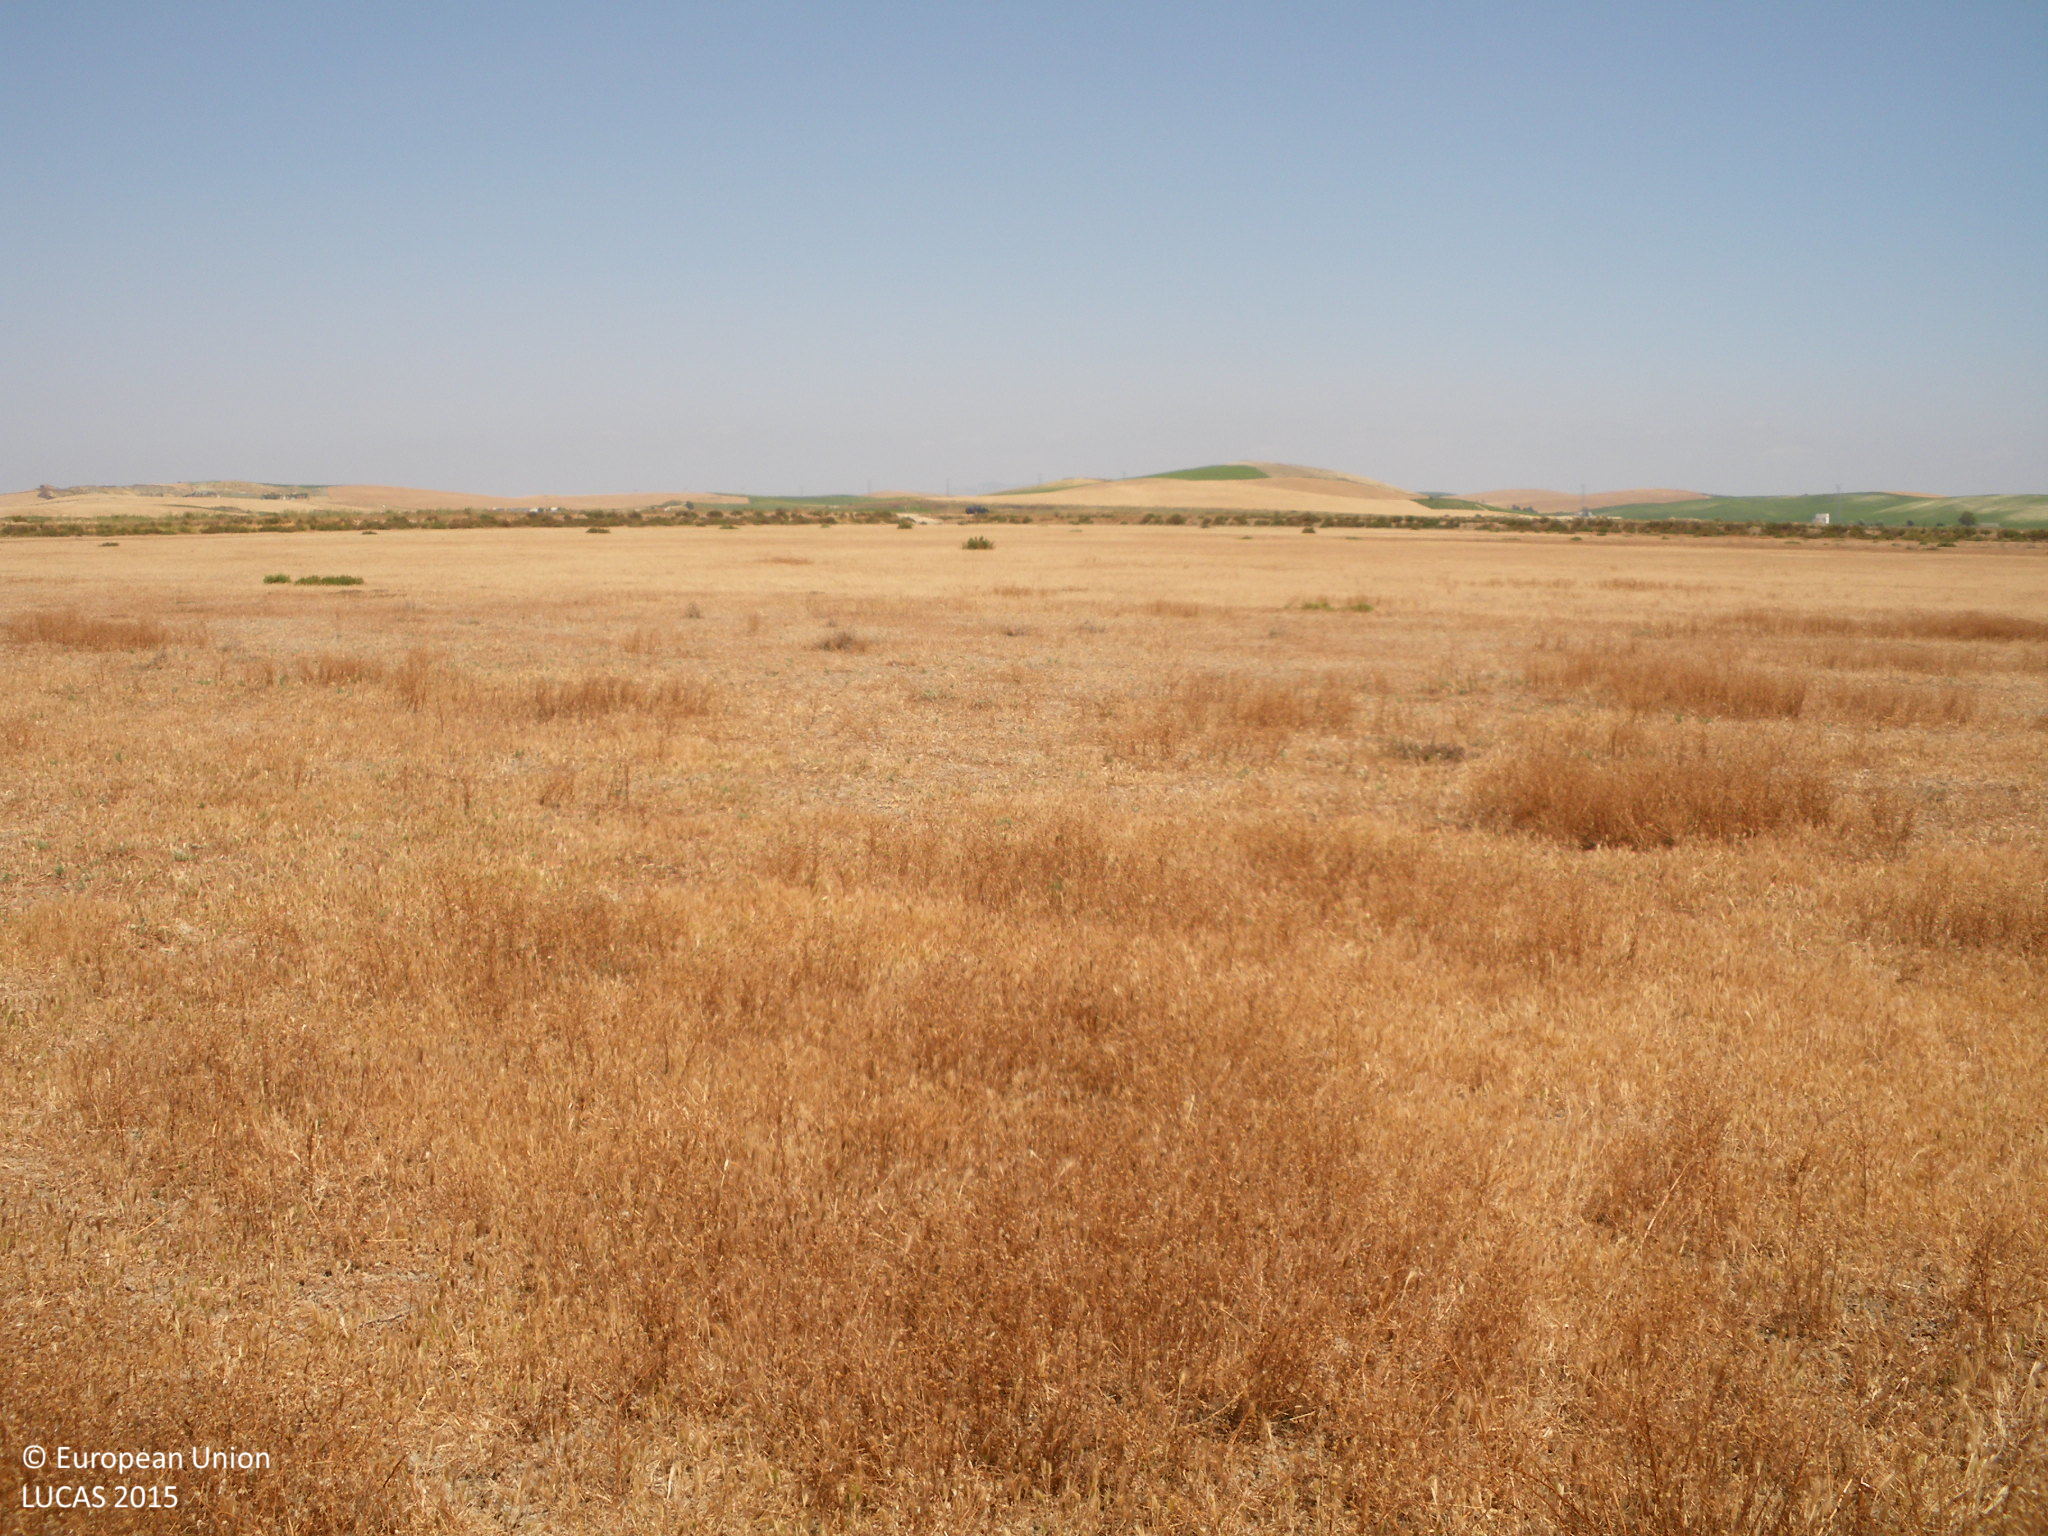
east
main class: Grassland
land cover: Spontaneously vegetated surfaces
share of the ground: > 75 %
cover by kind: herbaceous plants 90 %, unconsolidated bare surface 10 %
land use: Agriculture (excluding fallow land and kitchen gardens)
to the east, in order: Spontaneously vegetated surfaces
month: May
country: ES
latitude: 36.8430
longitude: -6.2210
